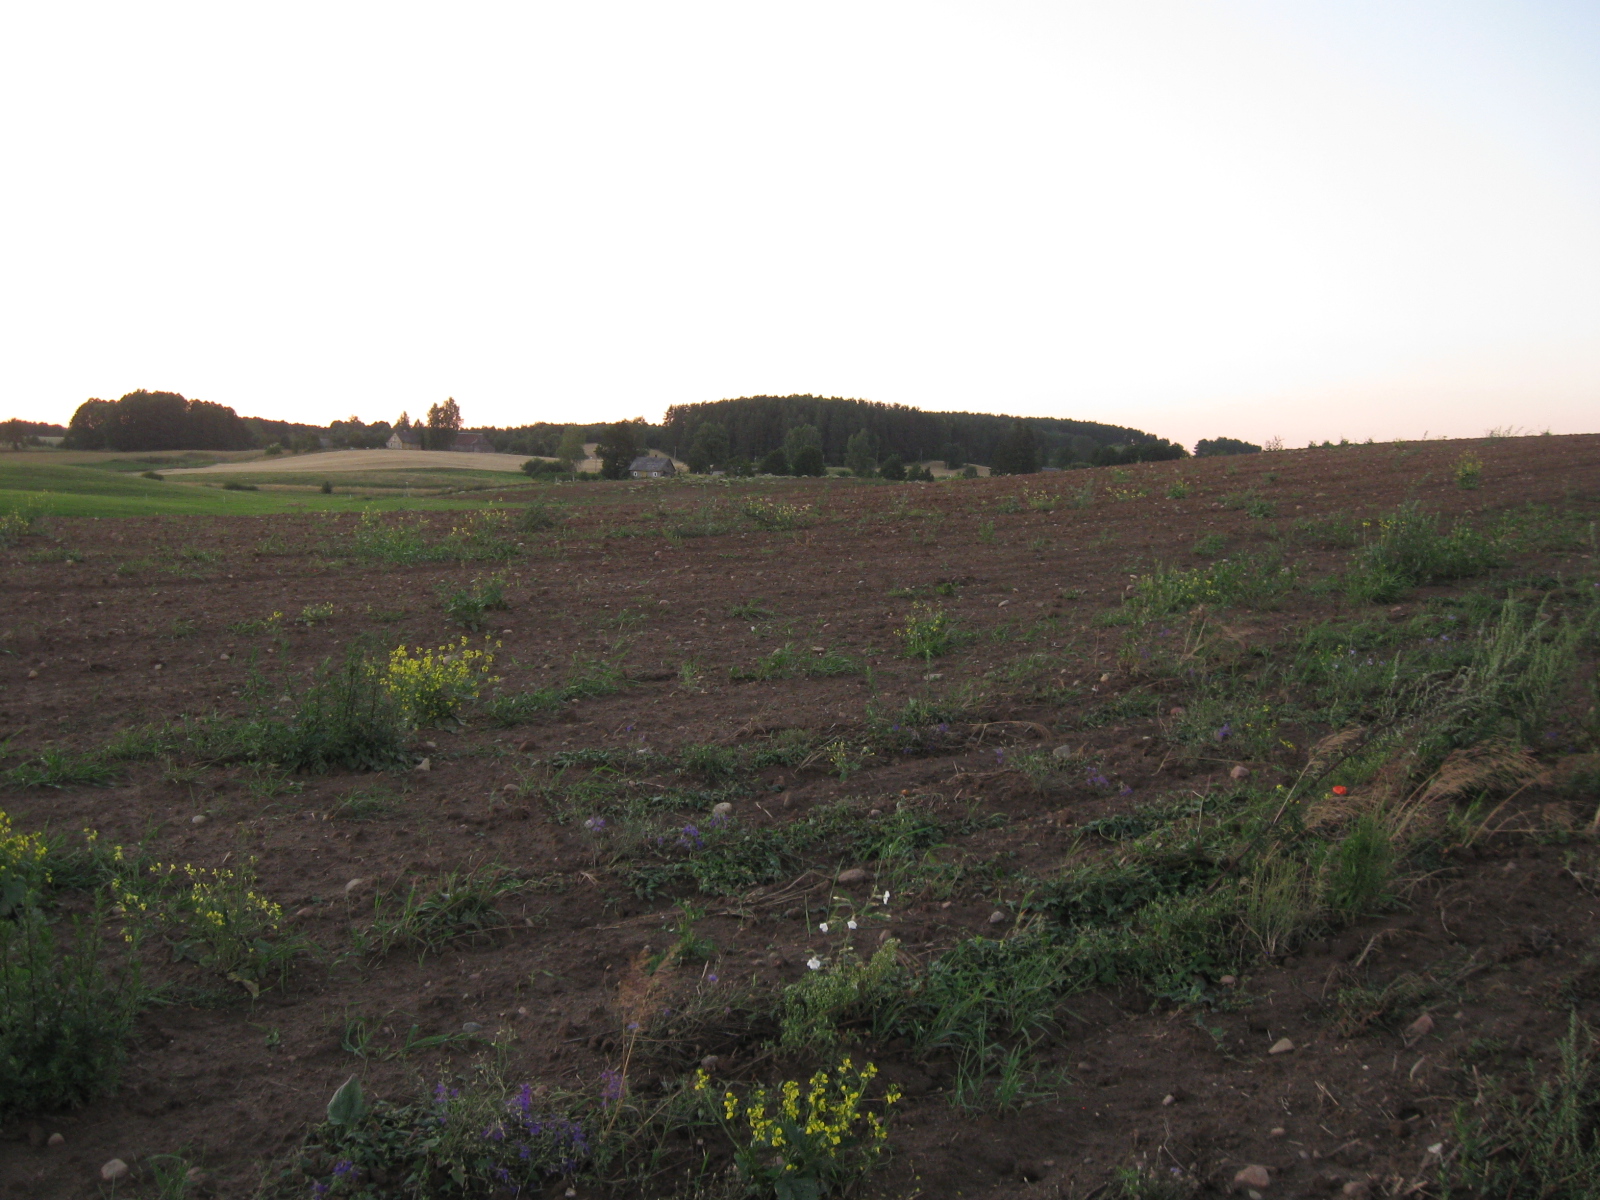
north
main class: Grassland
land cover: Spontaneously vegetated surfaces
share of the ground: 10 - 25 %
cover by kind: unconsolidated bare surface 80 %, herbaceous plants 20 %
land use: Agriculture (excluding fallow land and kitchen gardens)
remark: Tilled/Sowed
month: July
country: LT
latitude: 54.1098
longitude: 23.7469
